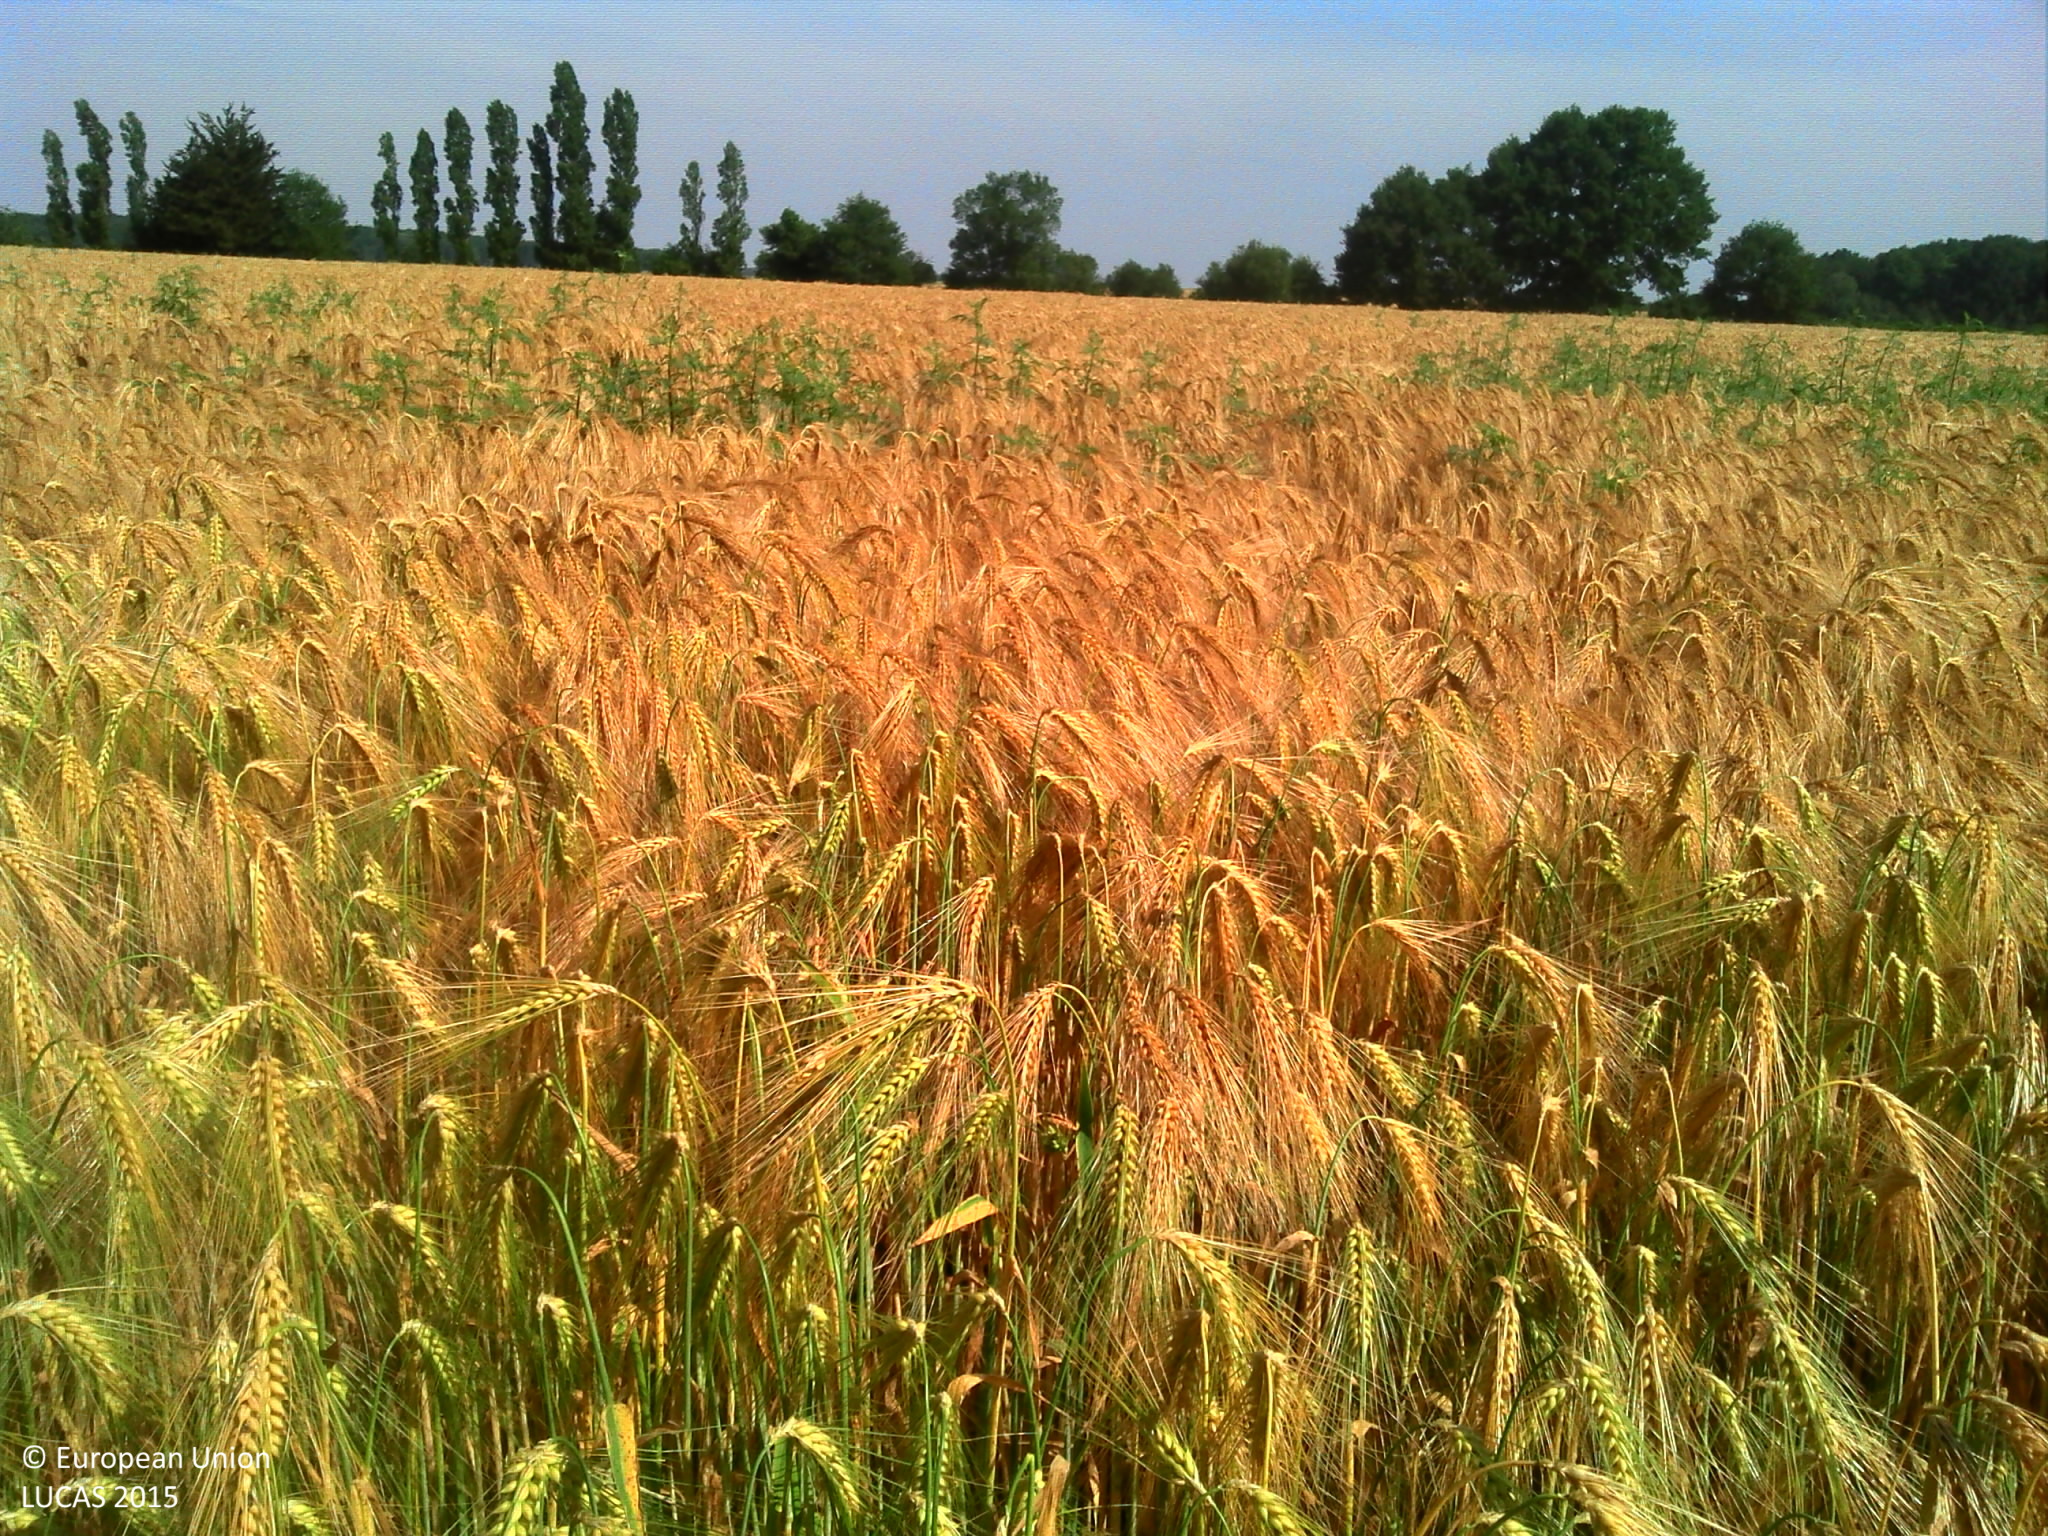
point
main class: Cropland
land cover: Barley
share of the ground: > 75 %
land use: Agriculture (excluding fallow land and kitchen gardens)
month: June
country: FR
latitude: 47.5639
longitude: 0.7697
